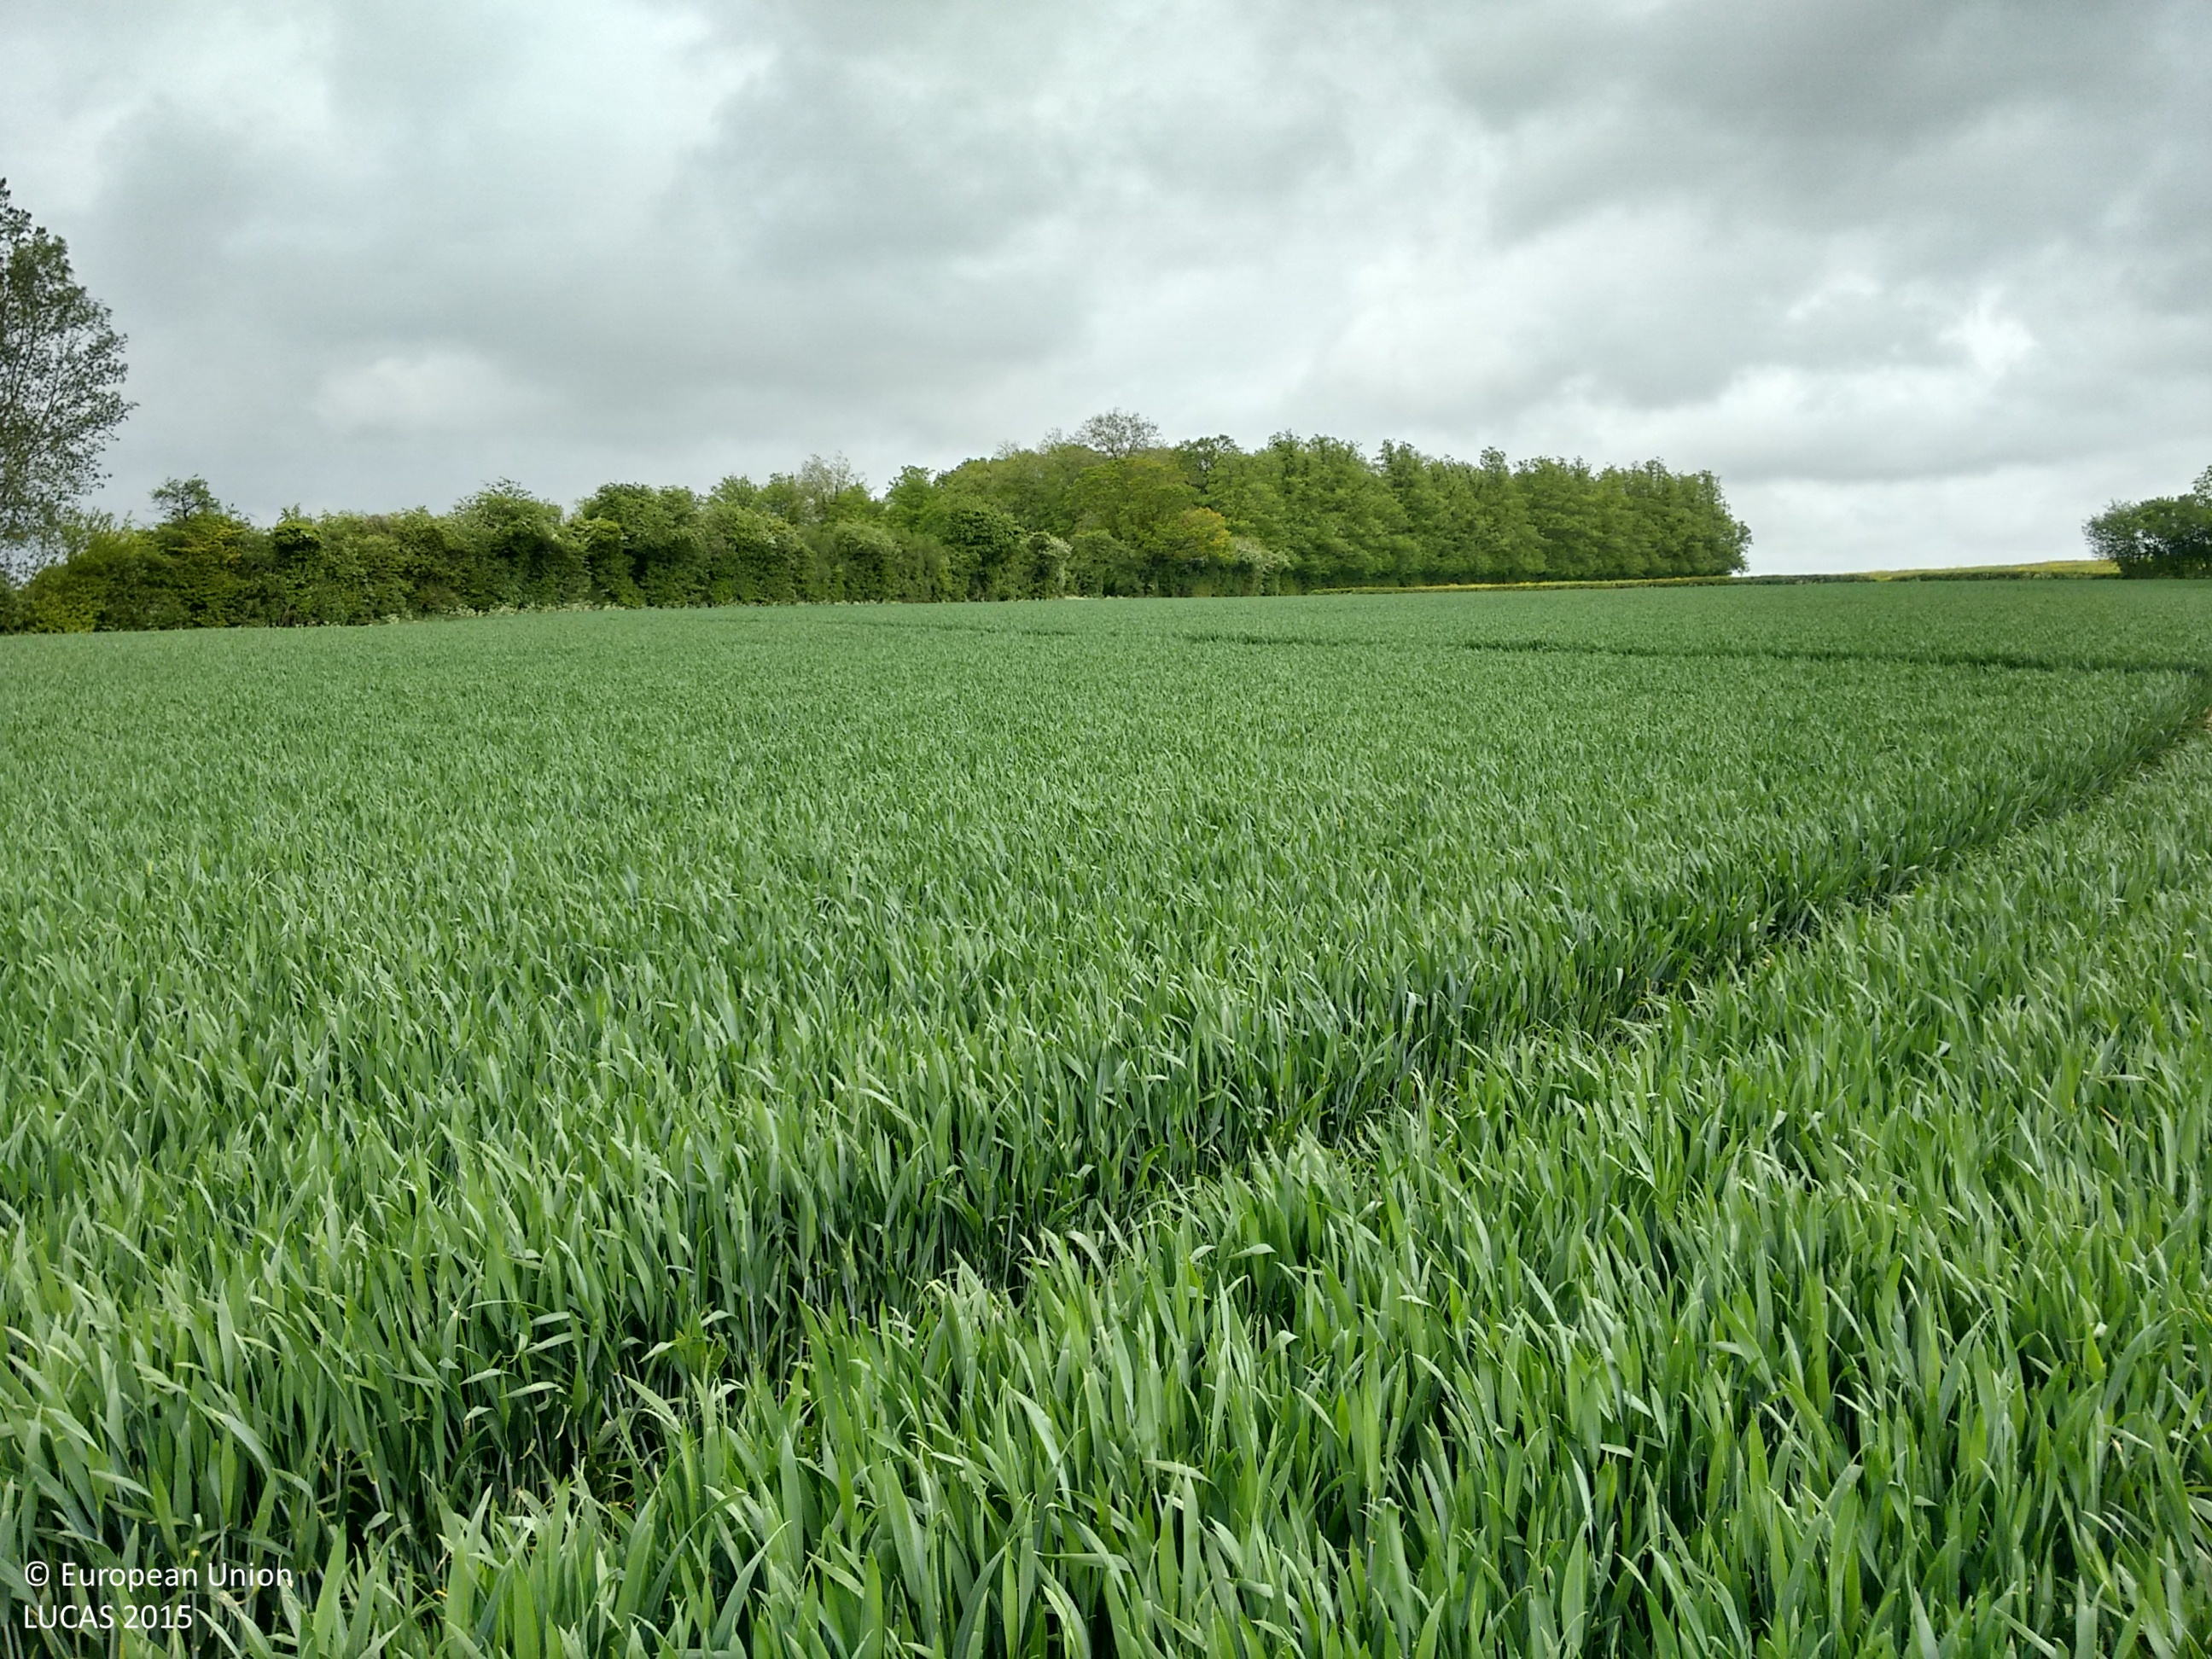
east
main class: Cropland
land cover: Common wheat
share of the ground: > 75 %
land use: Agriculture (excluding fallow land and kitchen gardens)
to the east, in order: Common wheat; Tracks; Common wheat; Grass margins; Managed hedges; Fences; Grassland without tree/shrub cover; Shruby margins; Fences; Grass margins; Paved roads, cycling and walking lanes; Grass margins; Fences; Broadleaved woodland
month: May
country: GB
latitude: 51.1984
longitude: 0.7149
